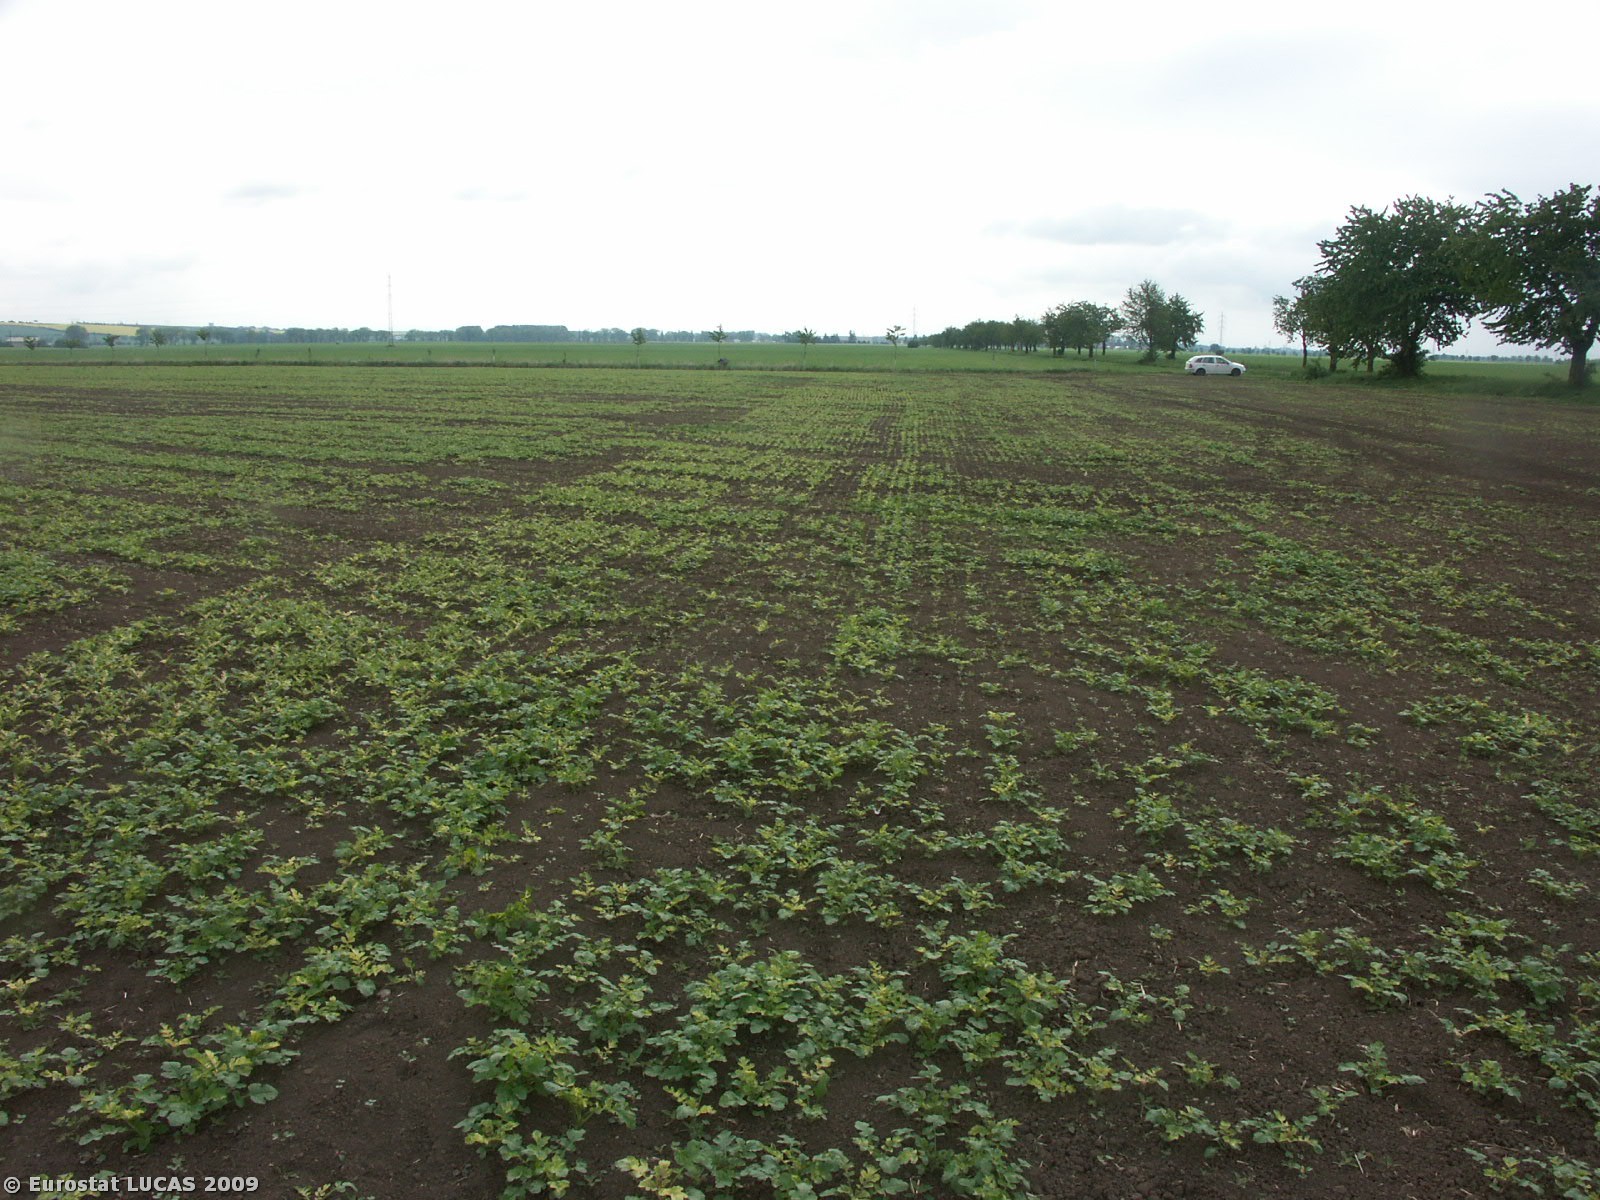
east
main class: Cropland
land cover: Other fibre and oleaginous crops
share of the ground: 50 - 75 %
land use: Agriculture (excluding fallow land and kitchen gardens)
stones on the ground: < 10 %
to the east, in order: Other fibre and oleaginous crops; Grass margins; Lines of trees; Tracks; Barley
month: May
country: CZ
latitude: 49.5458
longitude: 17.1279
